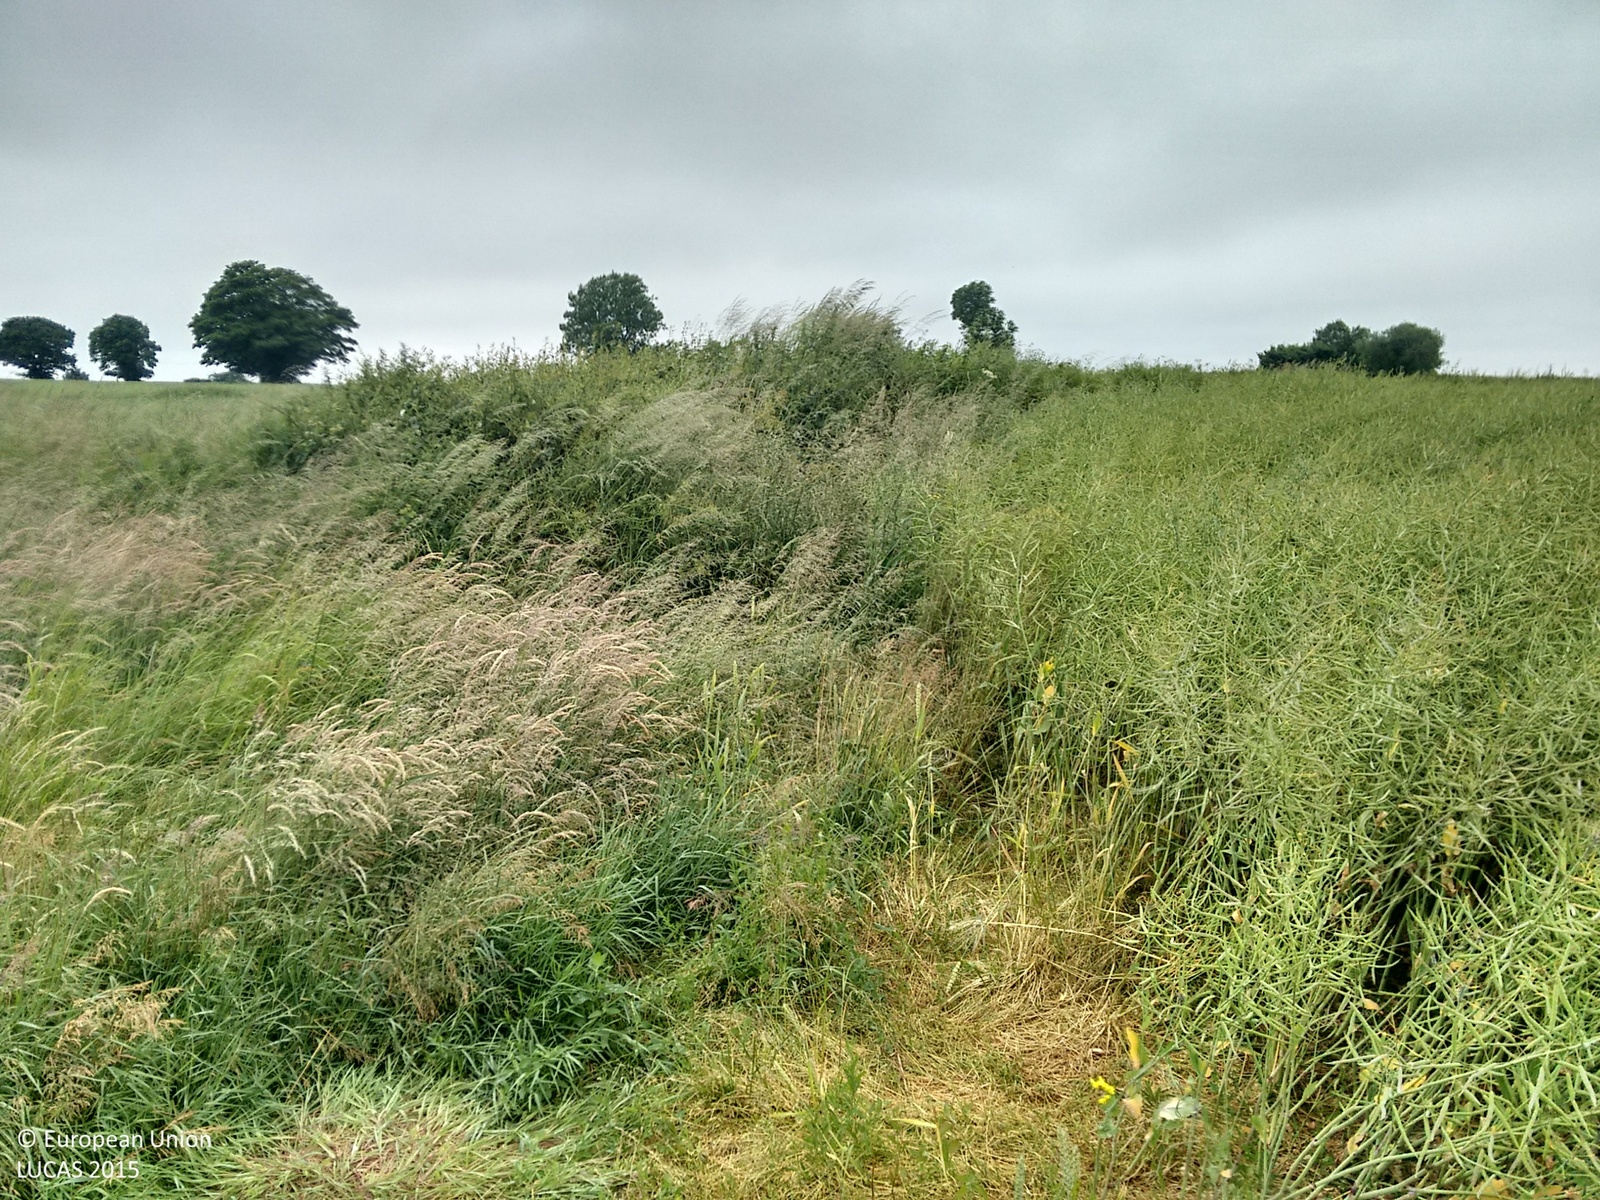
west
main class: Cropland
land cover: Dry pulses
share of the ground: > 75 %
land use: Agriculture (excluding fallow land and kitchen gardens)
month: June
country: IE
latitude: 52.4951
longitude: -7.2818
